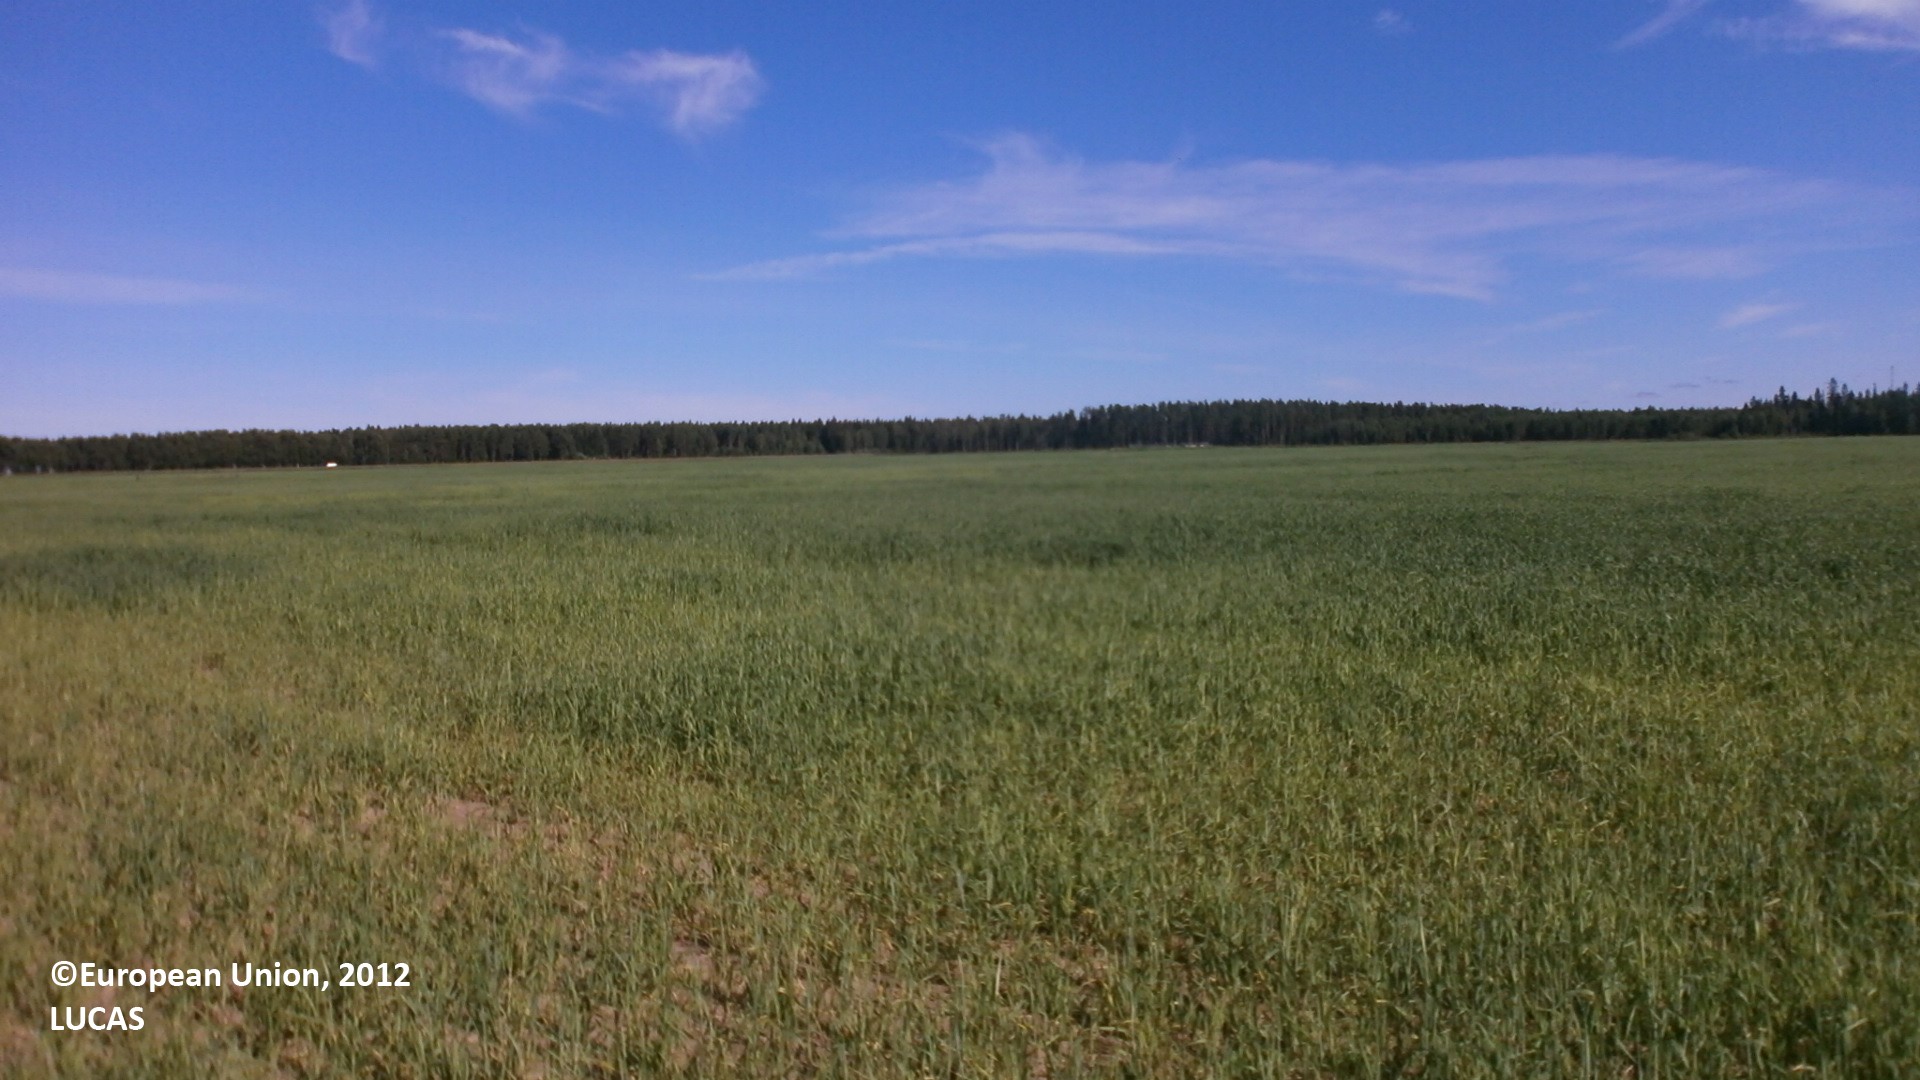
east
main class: Cropland
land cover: Barley
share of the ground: > 75 %
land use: Agriculture (excluding fallow land and kitchen gardens)
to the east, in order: Barley
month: July
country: FI
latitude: 64.2954
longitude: 23.9267
